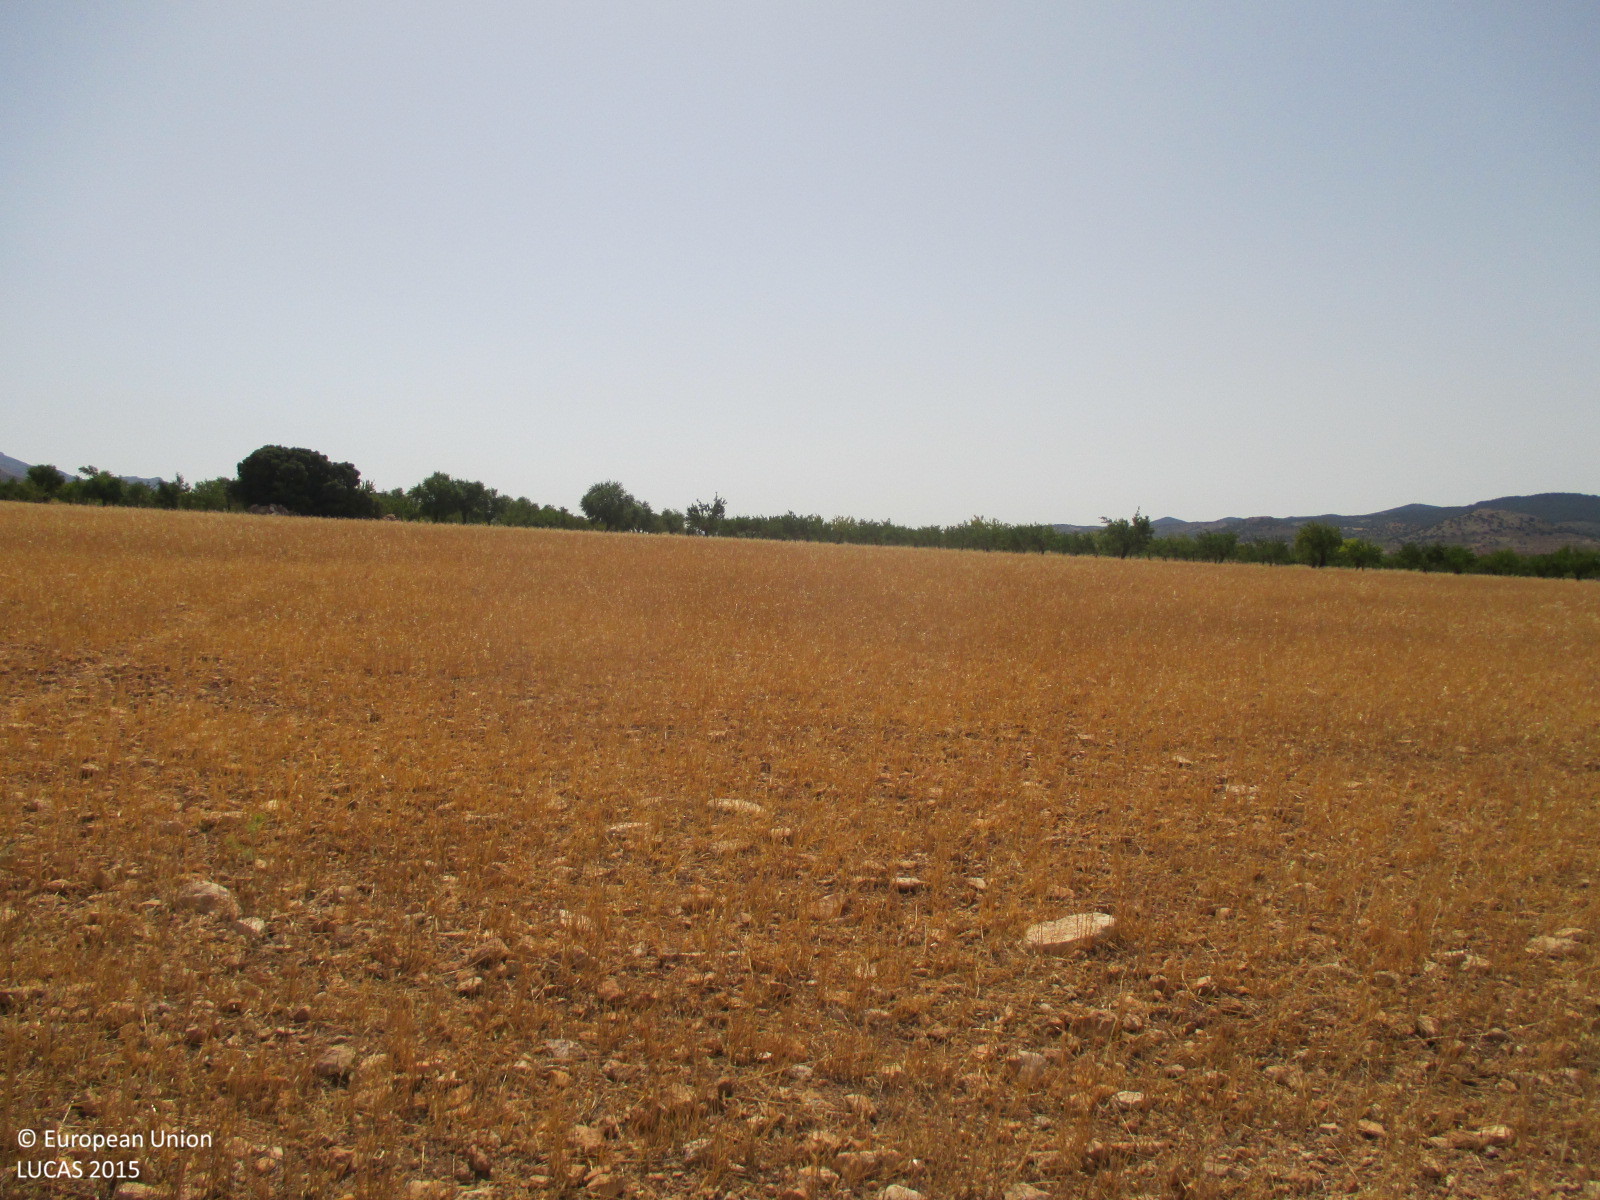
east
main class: Cropland
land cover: Oats
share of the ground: < 10 %
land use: Agriculture (excluding fallow land and kitchen gardens)
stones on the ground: < 10 %
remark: Harvested field
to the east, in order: Oats; Single bushes/trees; Oats; Grass margins; Tracks; Grass margins; Nuts trees
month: June
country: ES
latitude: 37.6059
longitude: -2.4352
